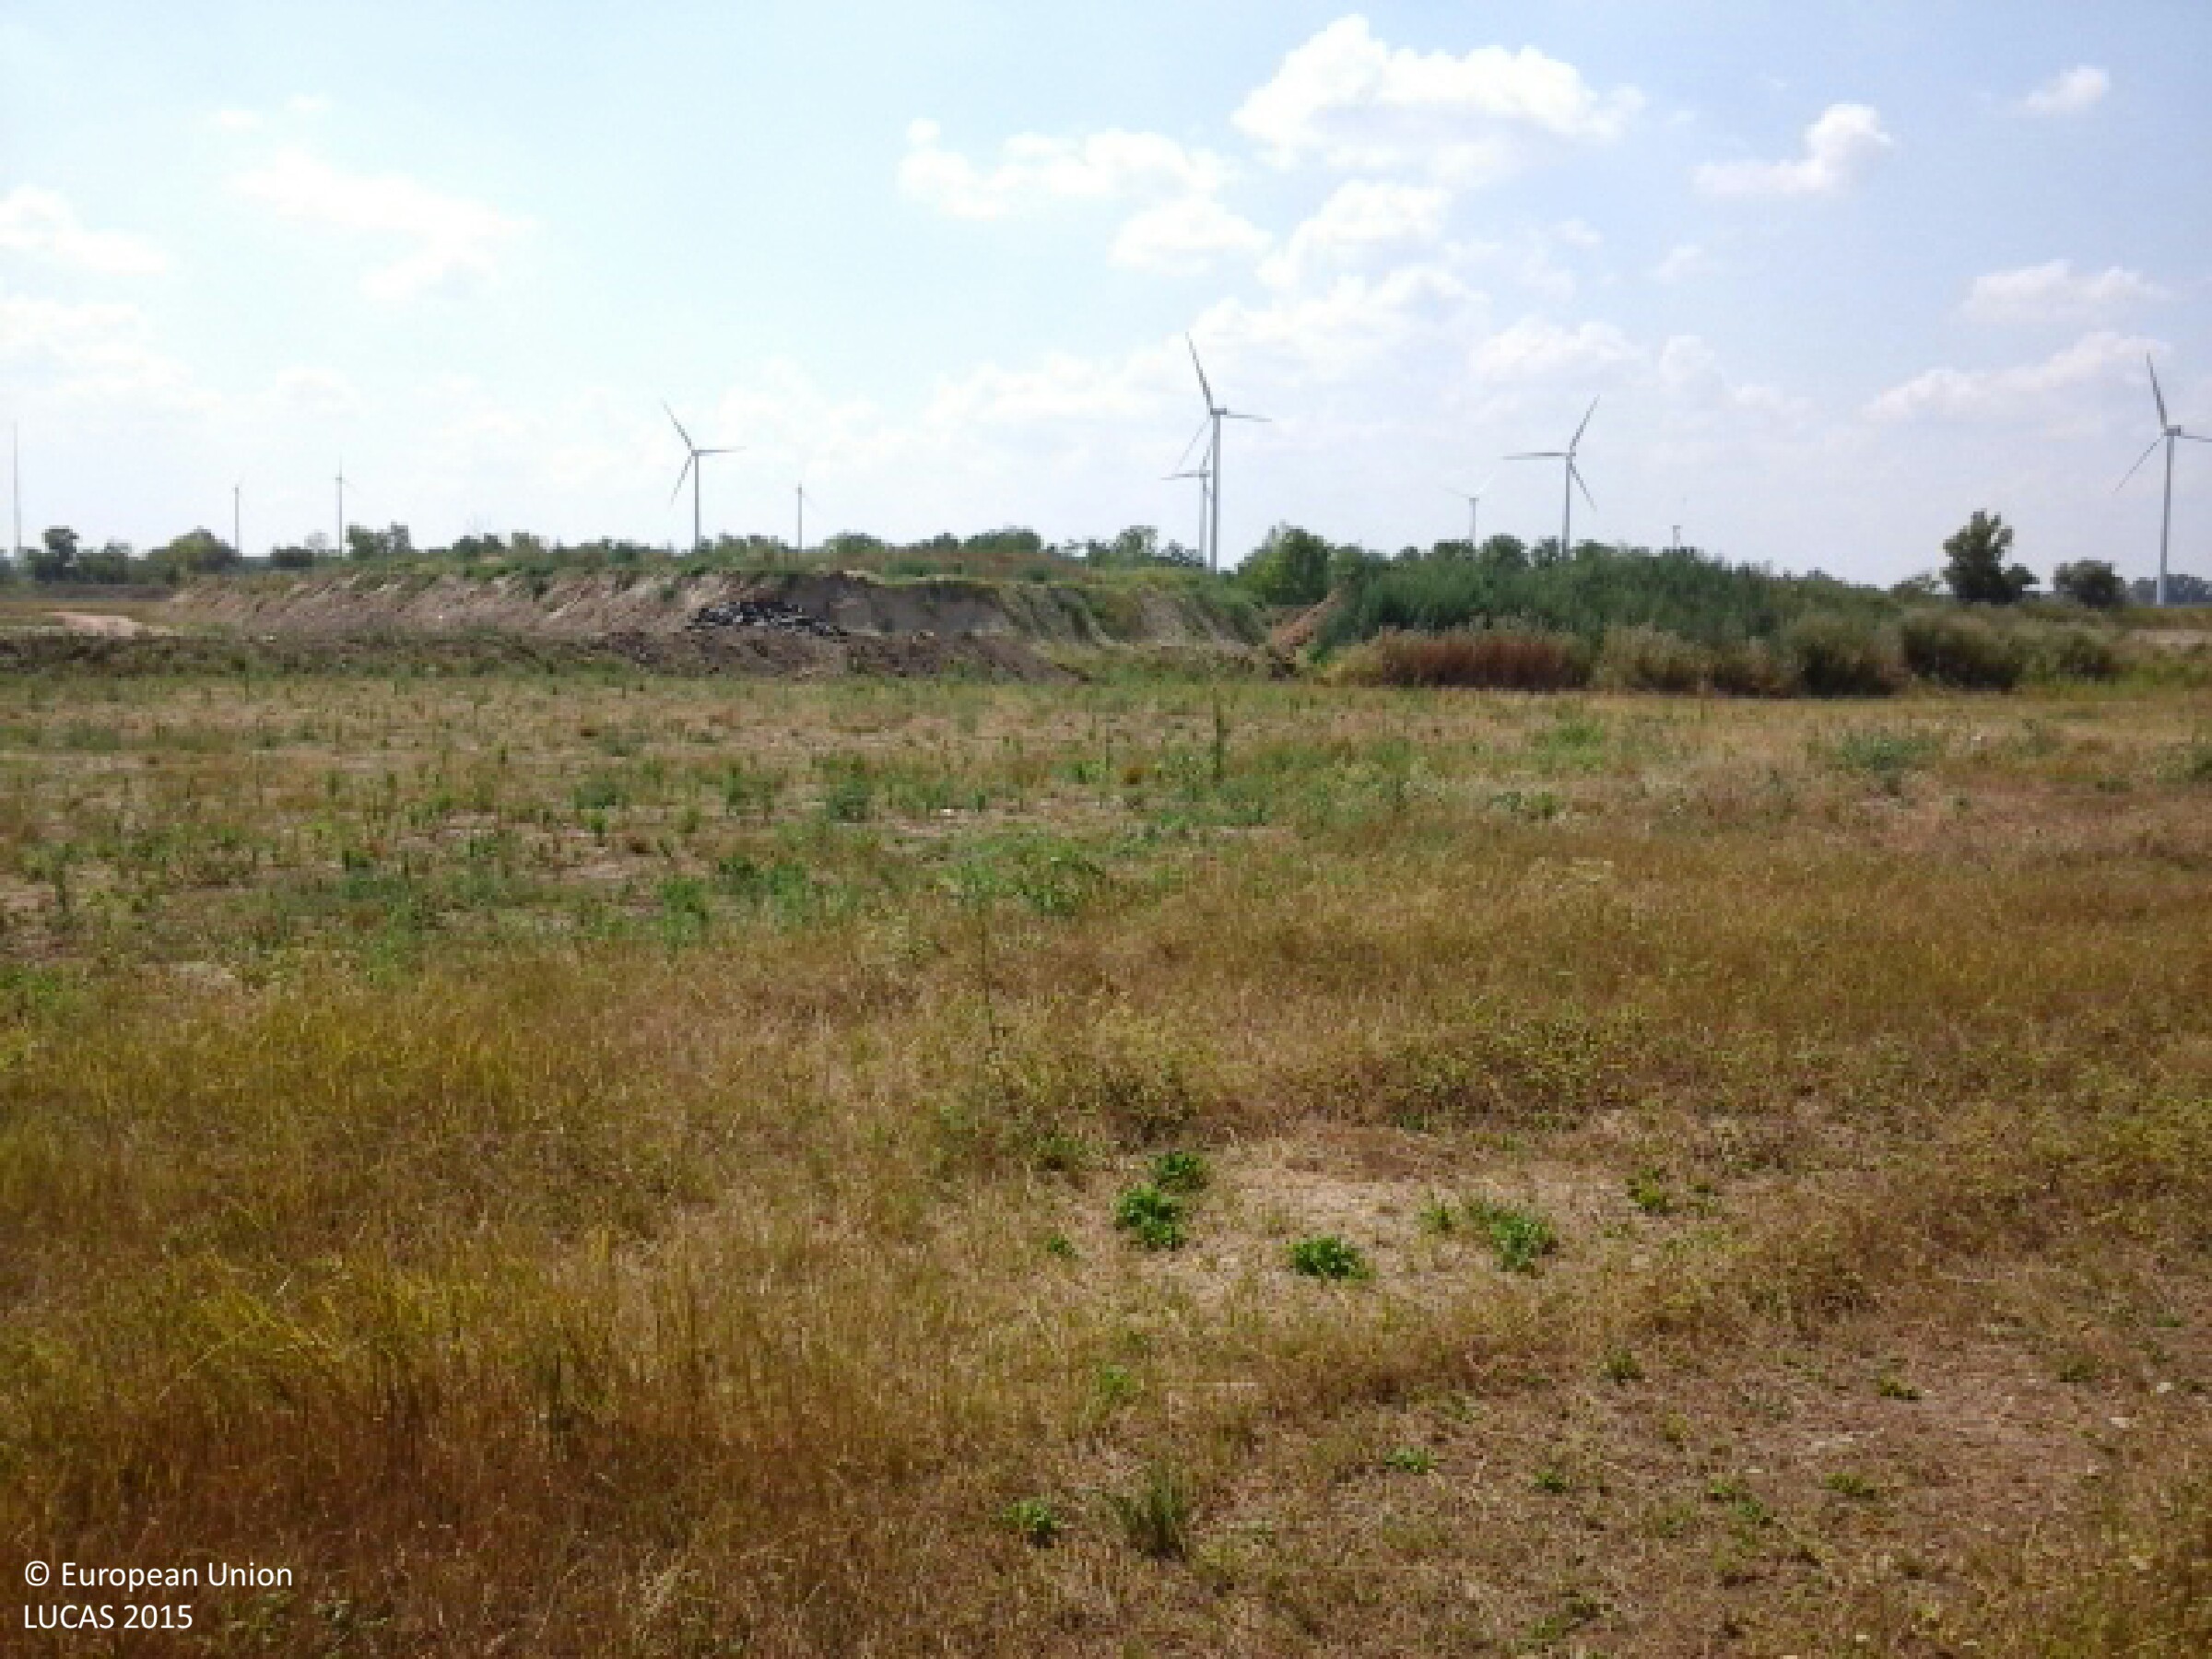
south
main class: Grassland
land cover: Spontaneously vegetated surfaces
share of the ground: > 75 %
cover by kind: herbaceous plants 95 %, shrubs 5 %
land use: Abandoned areas
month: August
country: HU
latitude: 47.6921
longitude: 18.0726
